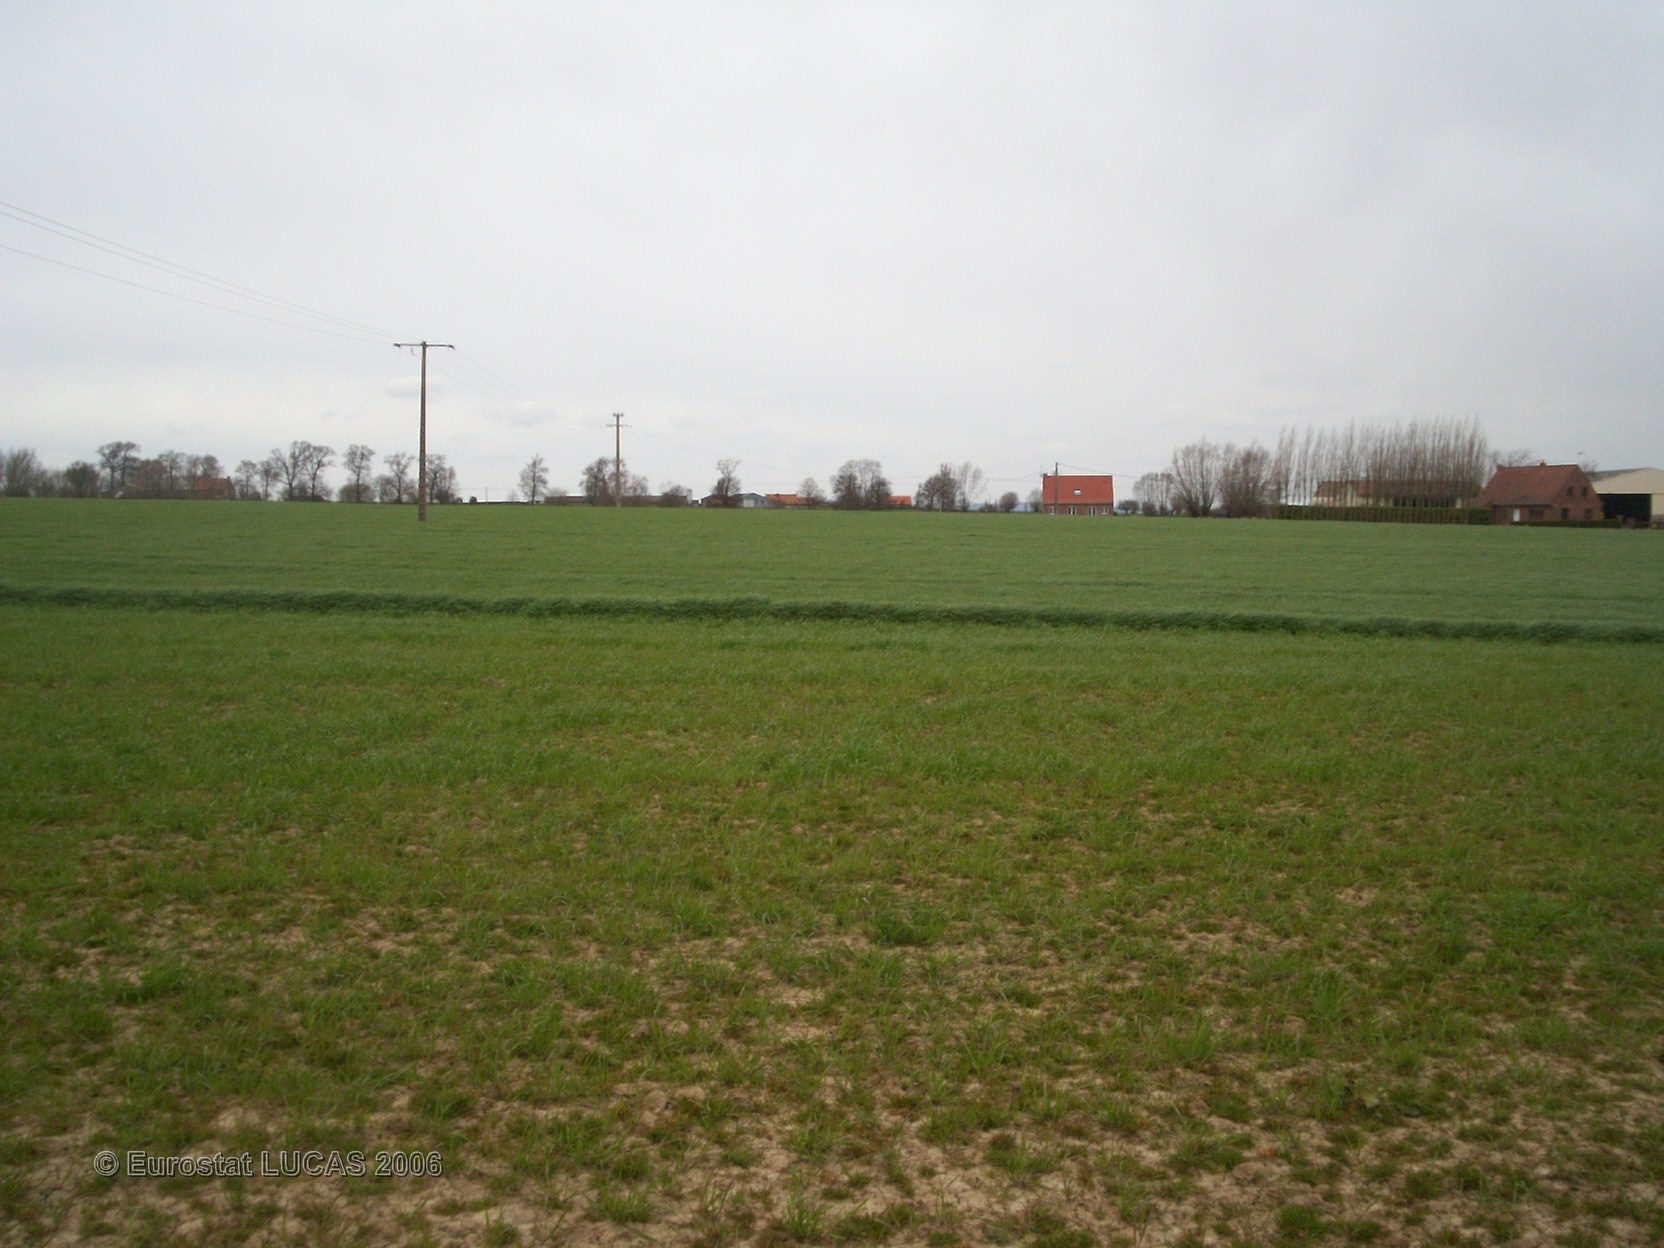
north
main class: Cropland
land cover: Oats
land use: Agriculture (excluding fallow land and kitchen gardens)
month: April
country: FR
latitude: 50.6936
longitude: 2.4700
